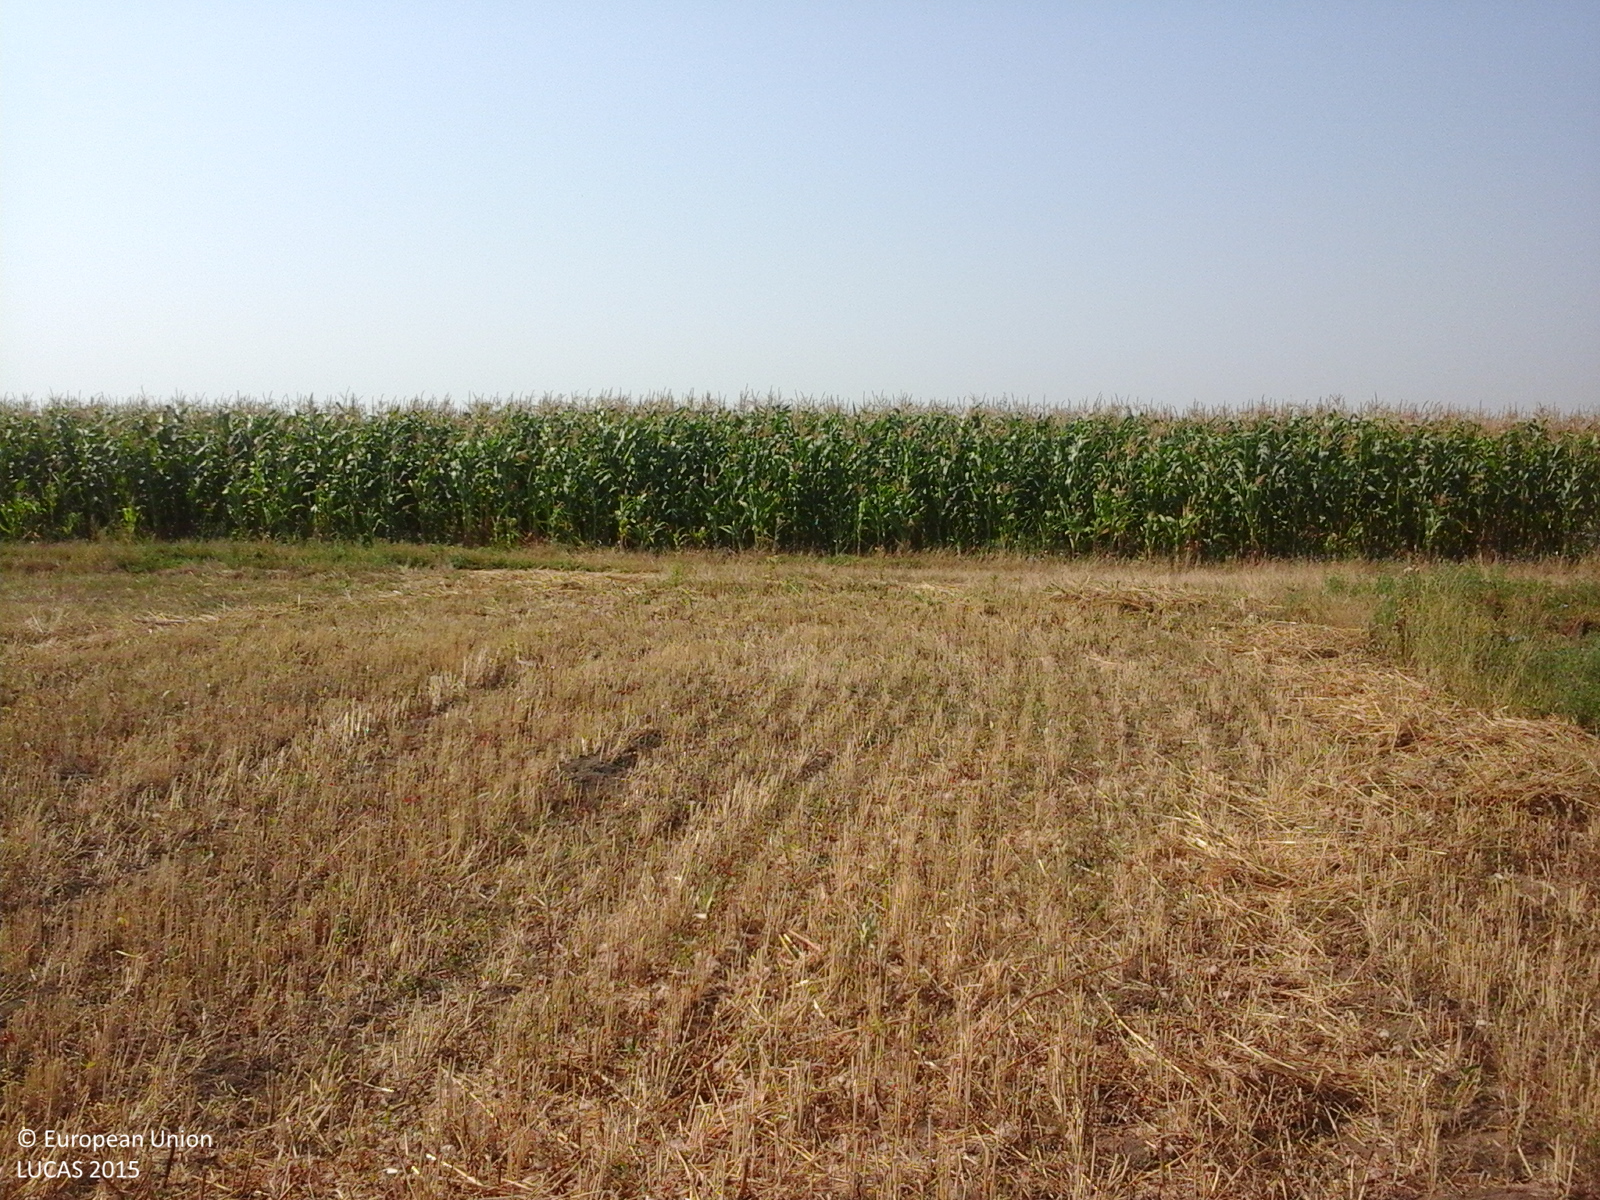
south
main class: Cropland
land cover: Common wheat
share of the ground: > 75 %
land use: Agriculture (excluding fallow land and kitchen gardens)
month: August
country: RO
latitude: 45.1532
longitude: 27.3819
